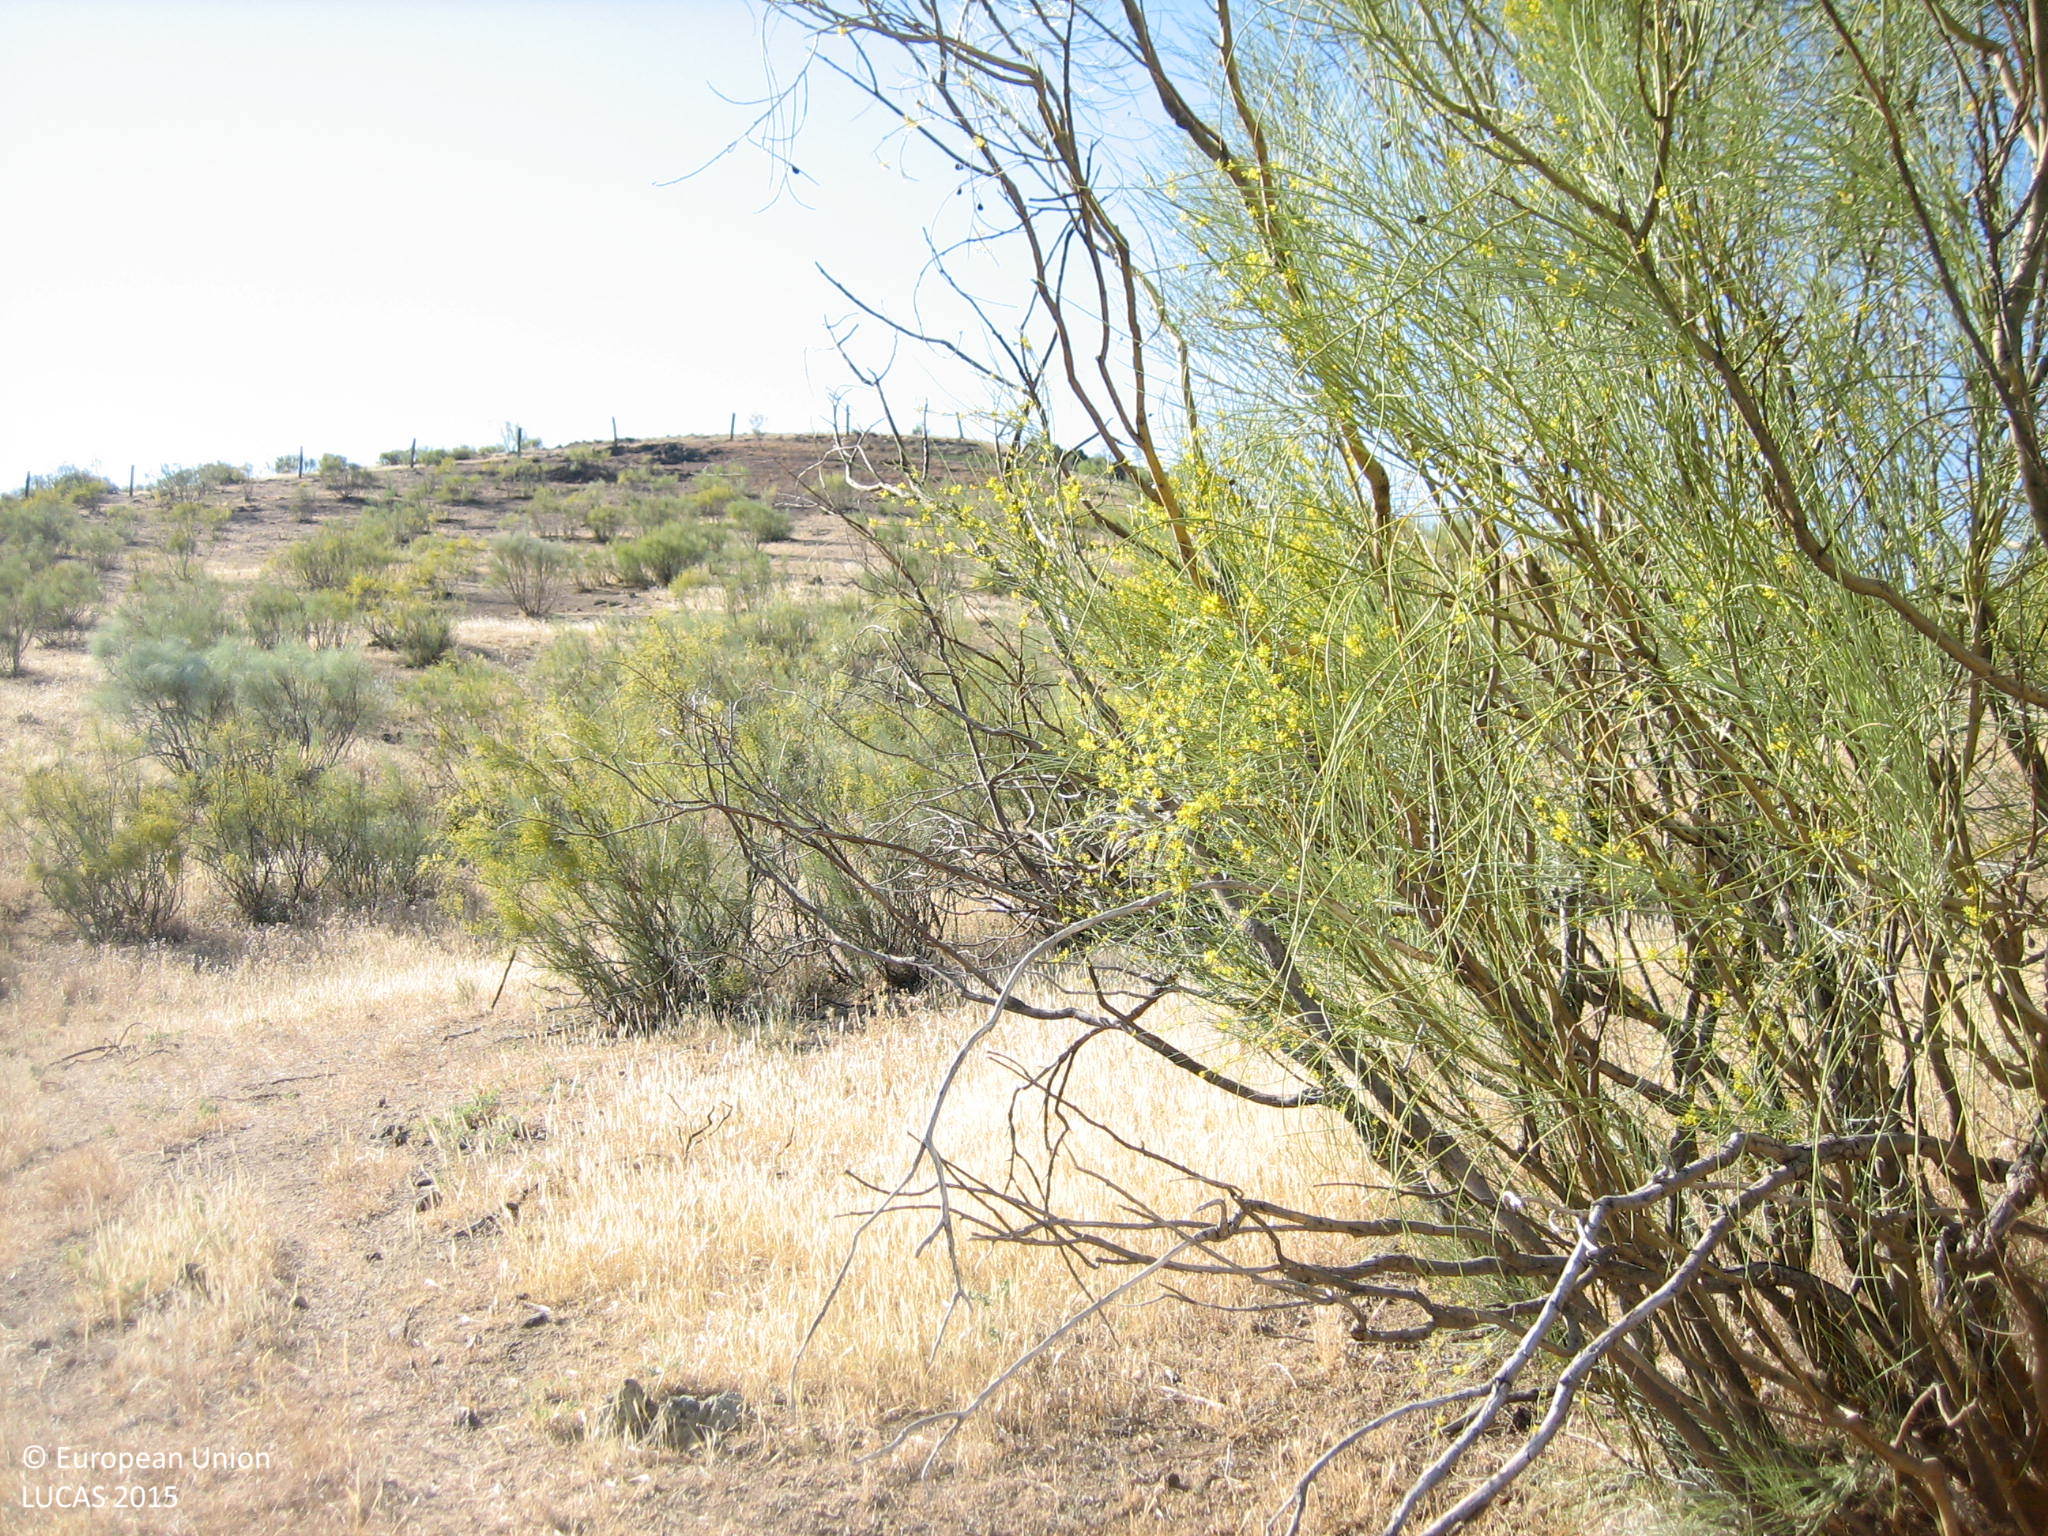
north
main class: Grassland
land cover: Grassland with sparse tree/shrub cover
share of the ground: > 75 %
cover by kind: herbaceous plants 90 %, coniferous forest trees 5 %, shrubs 5 %
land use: Agriculture (excluding fallow land and kitchen gardens)
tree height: > 5 m
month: May
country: ES
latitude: 38.5537
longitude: -4.0494
